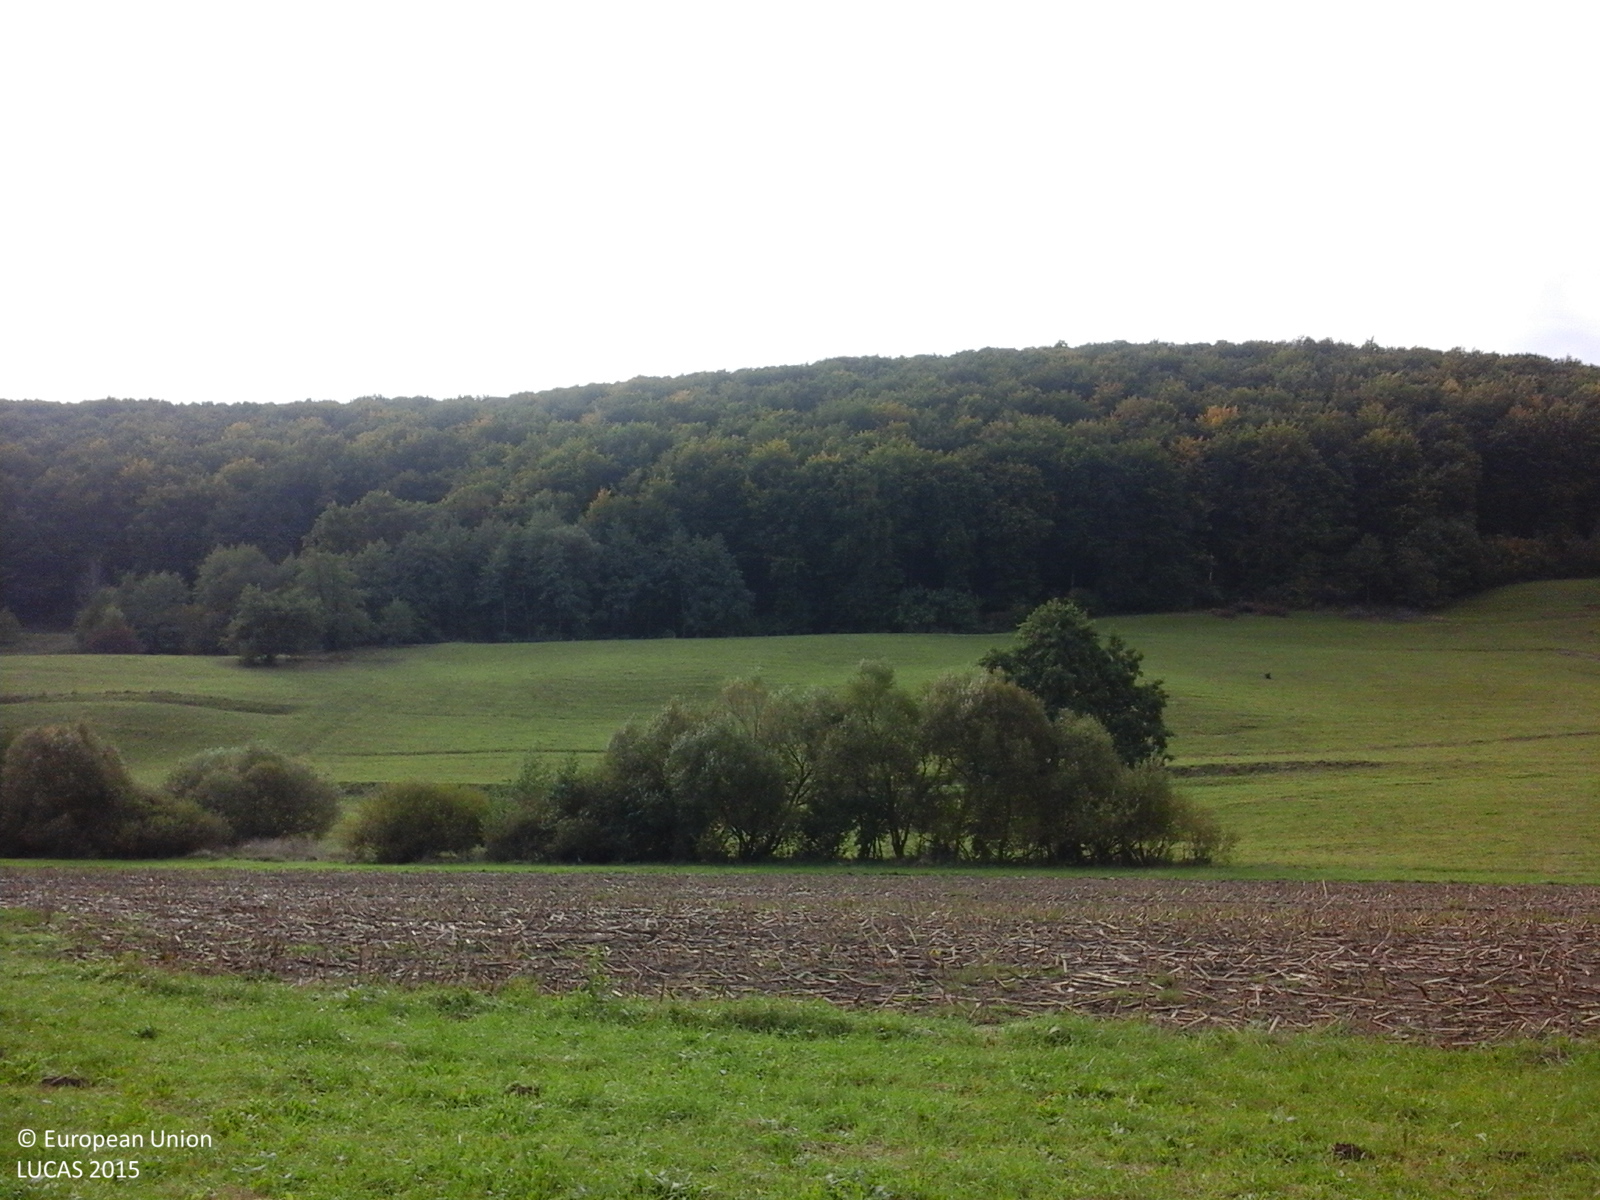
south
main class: Grassland
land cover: Grassland without tree/shrub cover
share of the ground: > 75 %
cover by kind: herbaceous plants 100 %
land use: Agriculture (excluding fallow land and kitchen gardens)
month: October
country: RO
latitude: 46.3574
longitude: 25.1893
